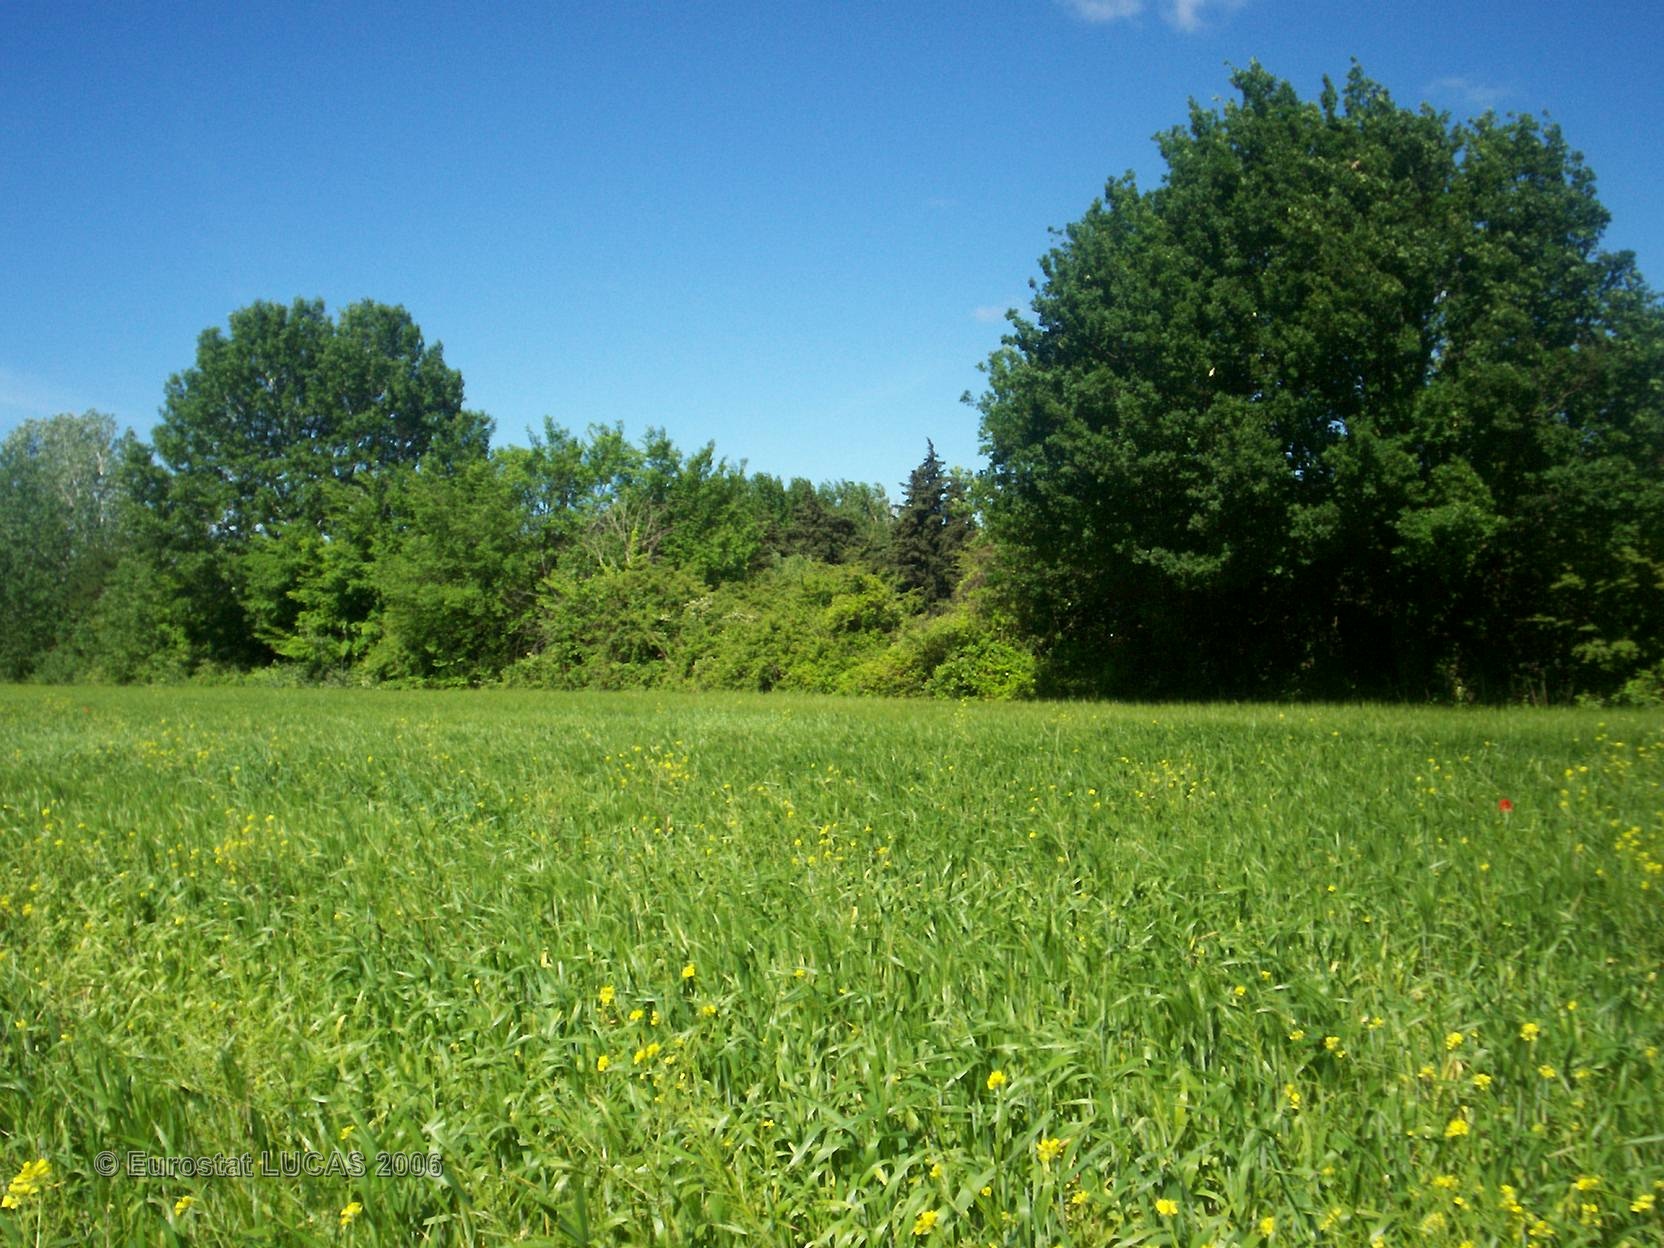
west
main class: Cropland
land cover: Durum wheat
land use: Agriculture (excluding fallow land and kitchen gardens)
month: May
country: FR
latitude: 43.9907
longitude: 4.9087
